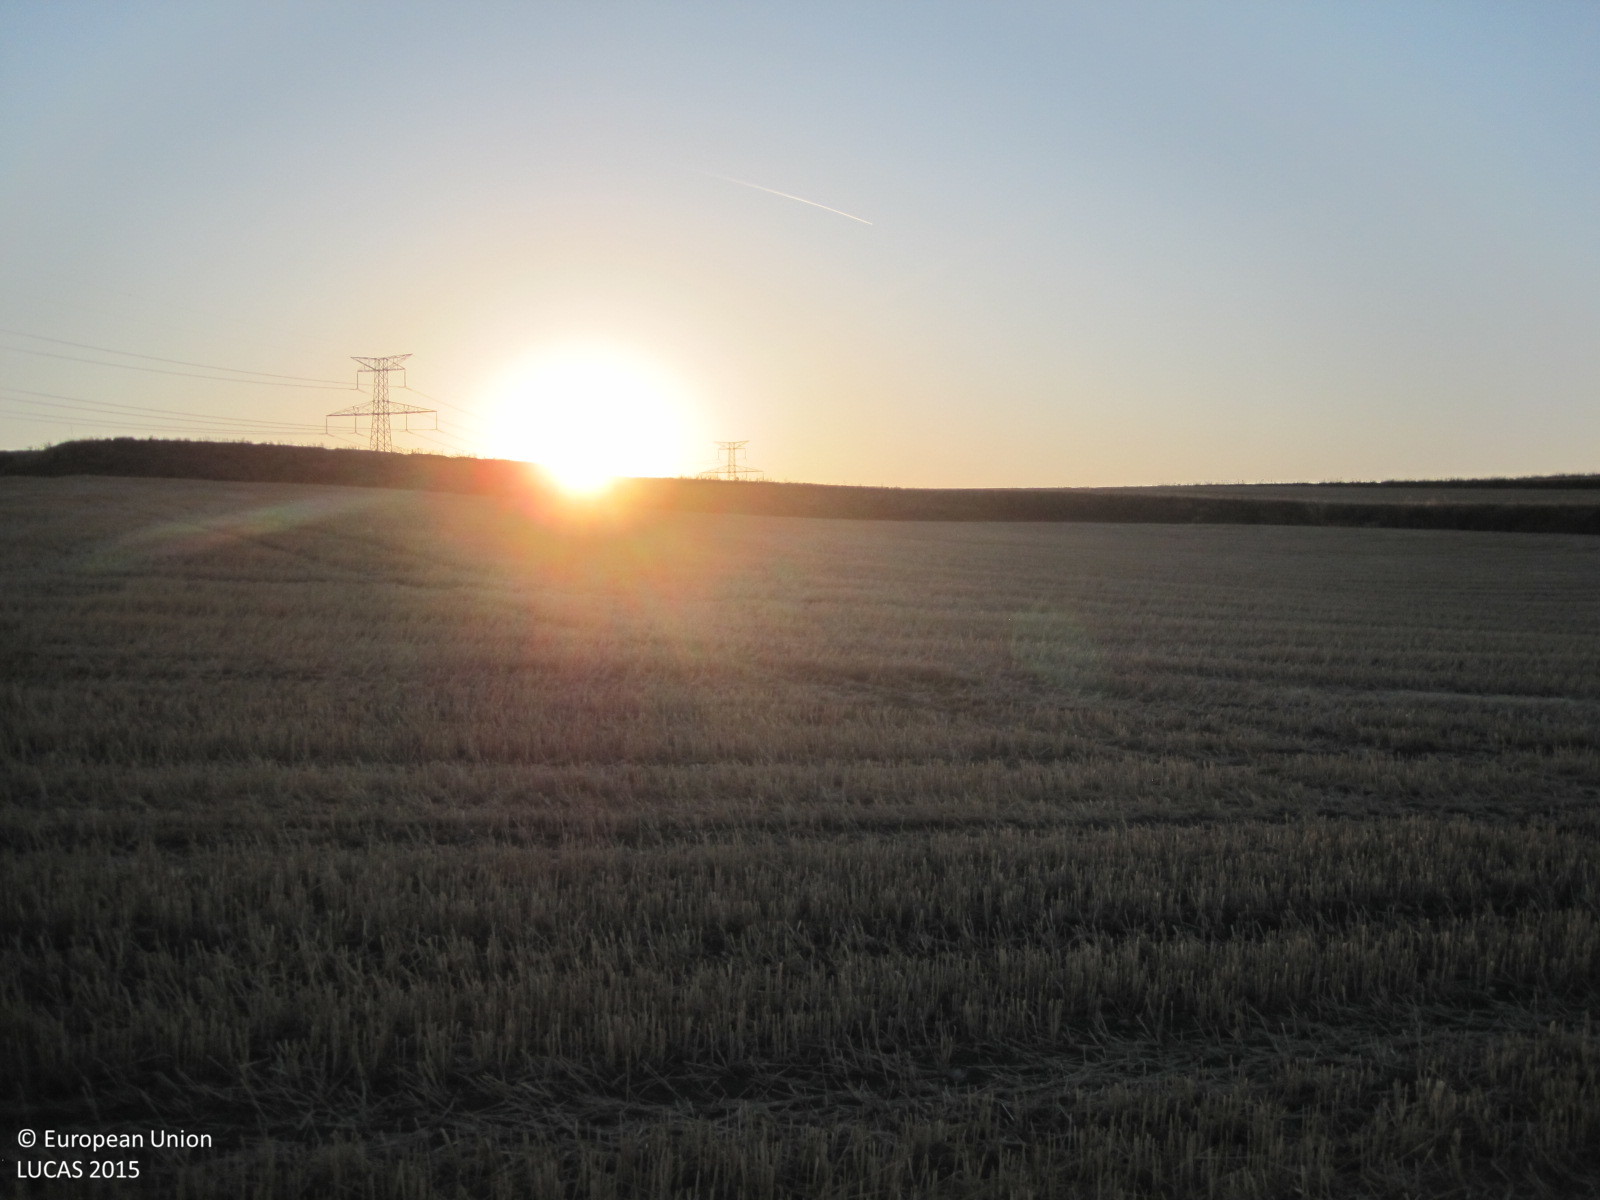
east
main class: Cropland
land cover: Barley
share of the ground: < 10 %
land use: Agriculture (excluding fallow land and kitchen gardens)
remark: Harvested field
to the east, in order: Barley; Grass margins; Common wheat; Grass margins; Barley; Grass margins; Barley
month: July
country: ES
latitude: 40.1087
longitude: -3.8200
